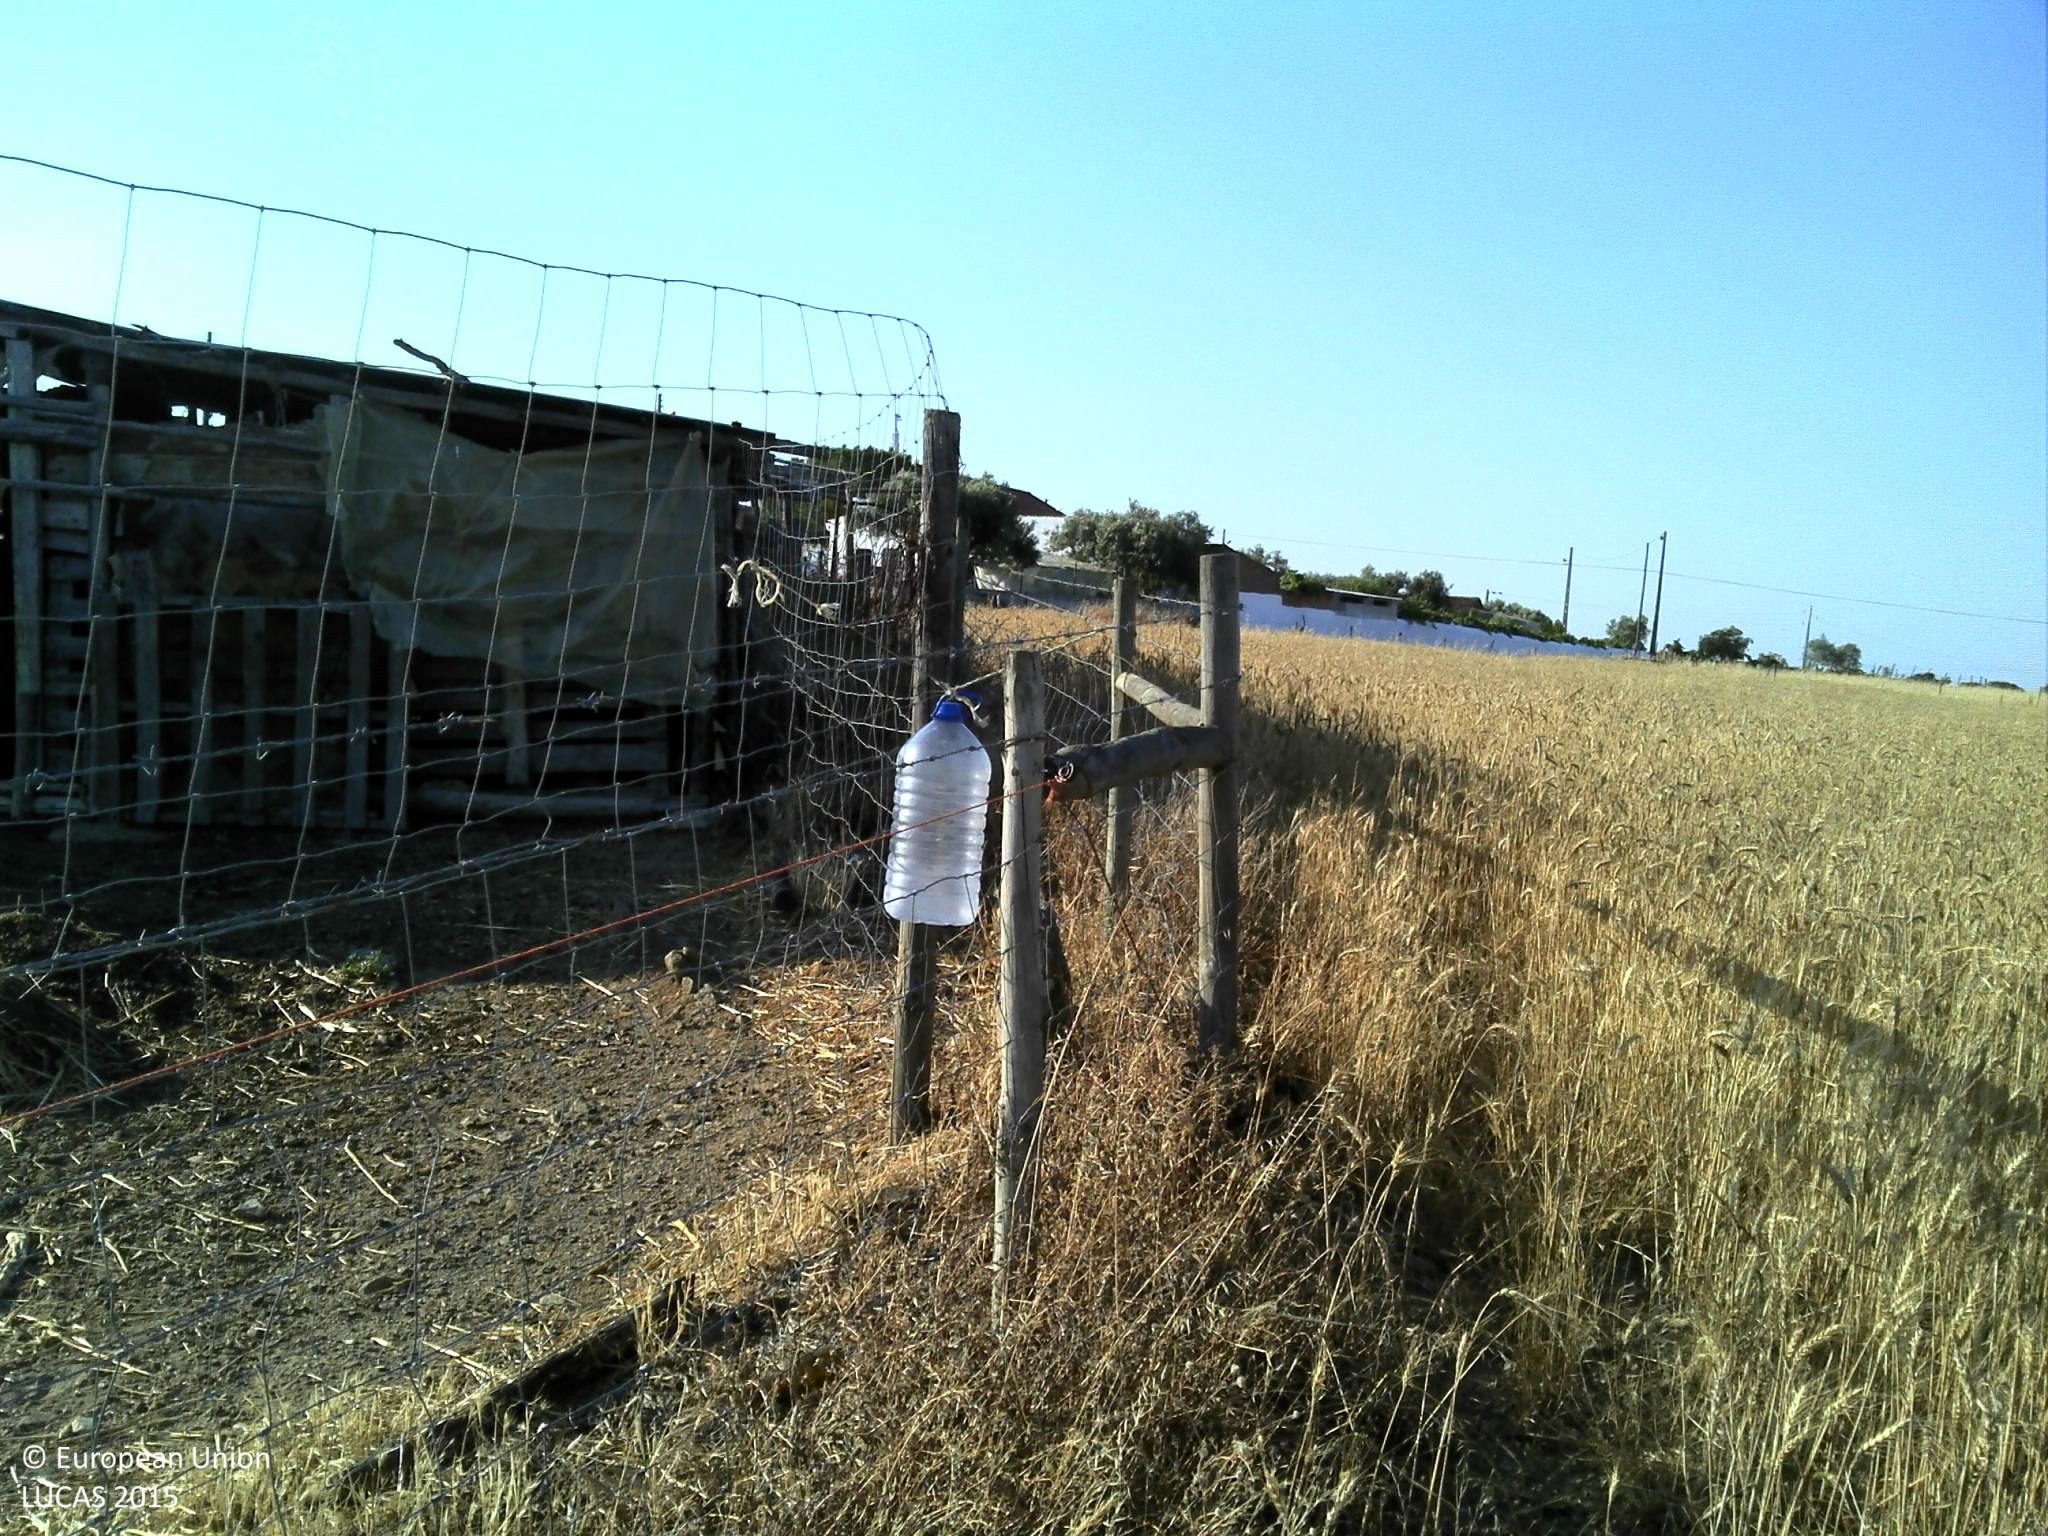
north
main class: Cropland
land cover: Common wheat
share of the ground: > 75 %
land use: Agriculture (excluding fallow land and kitchen gardens)
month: June
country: PT
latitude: 37.4745
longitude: -7.9180
